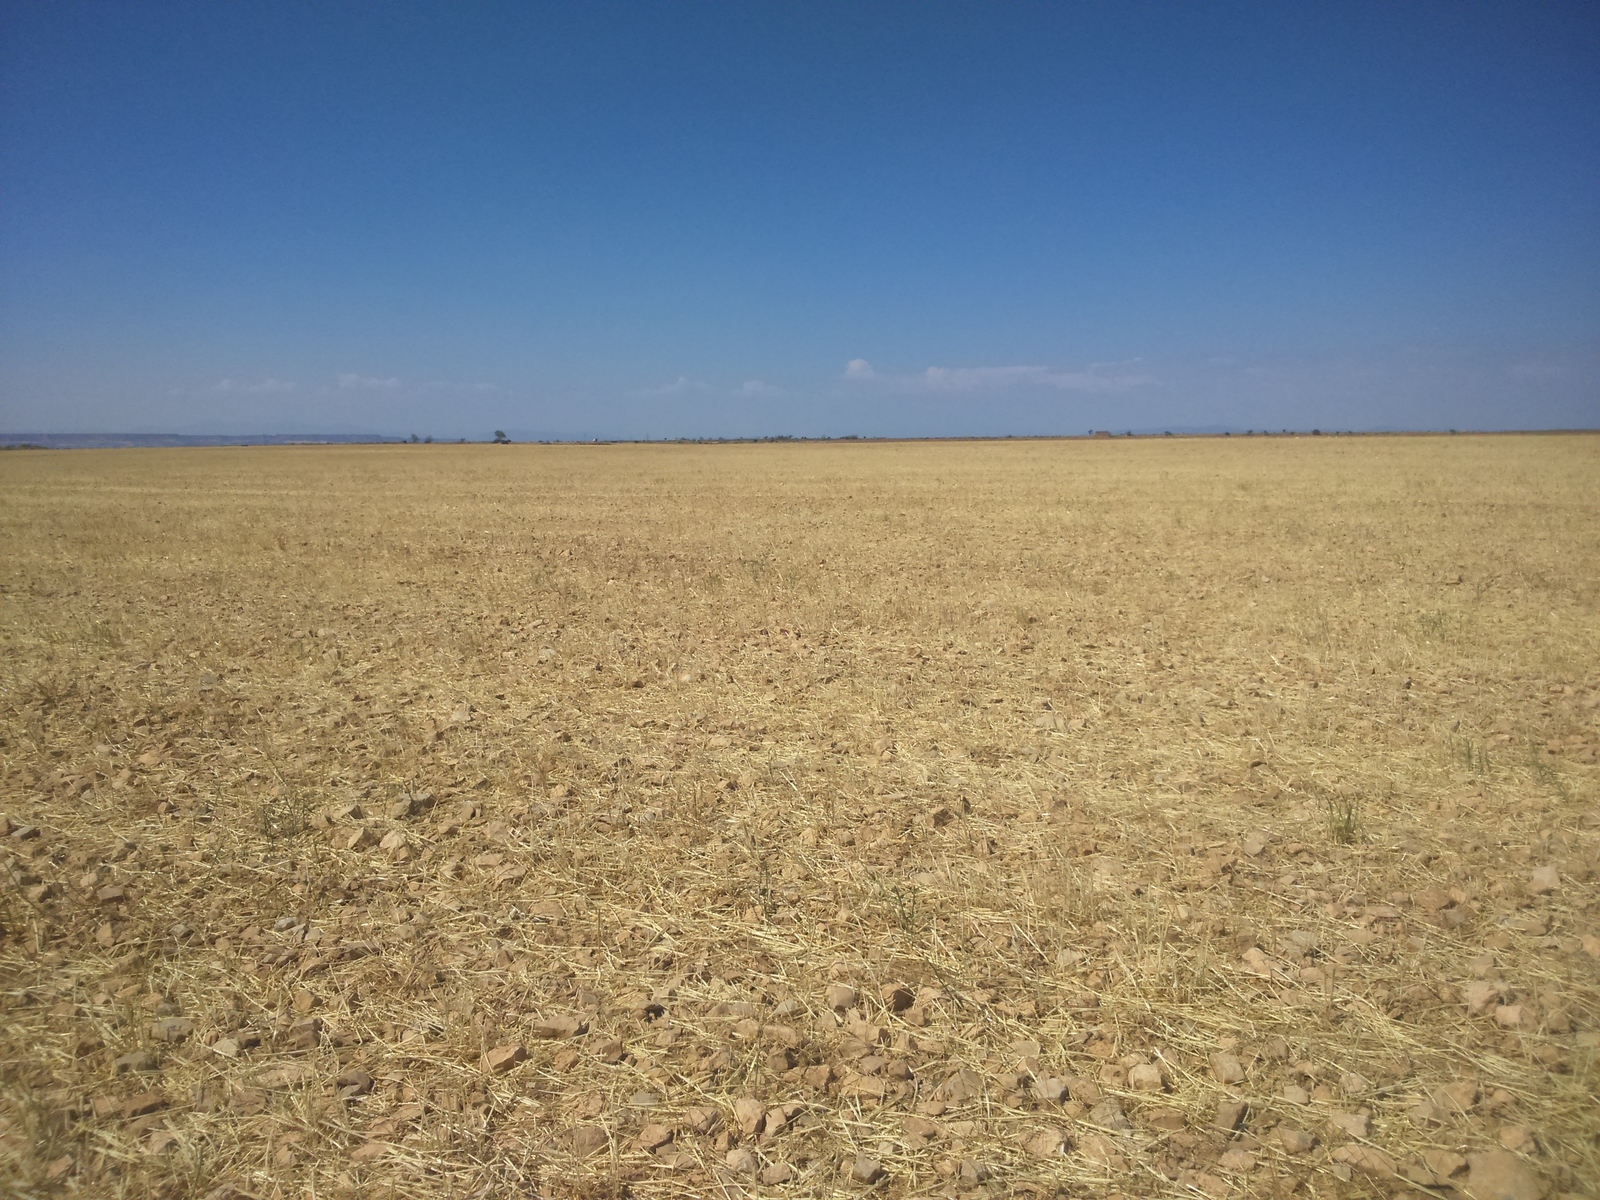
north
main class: Cropland
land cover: Barley
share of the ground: < 10 %
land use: Agriculture (excluding fallow land and kitchen gardens)
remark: Harvested field
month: June
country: ES
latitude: 41.6588
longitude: 0.1014
